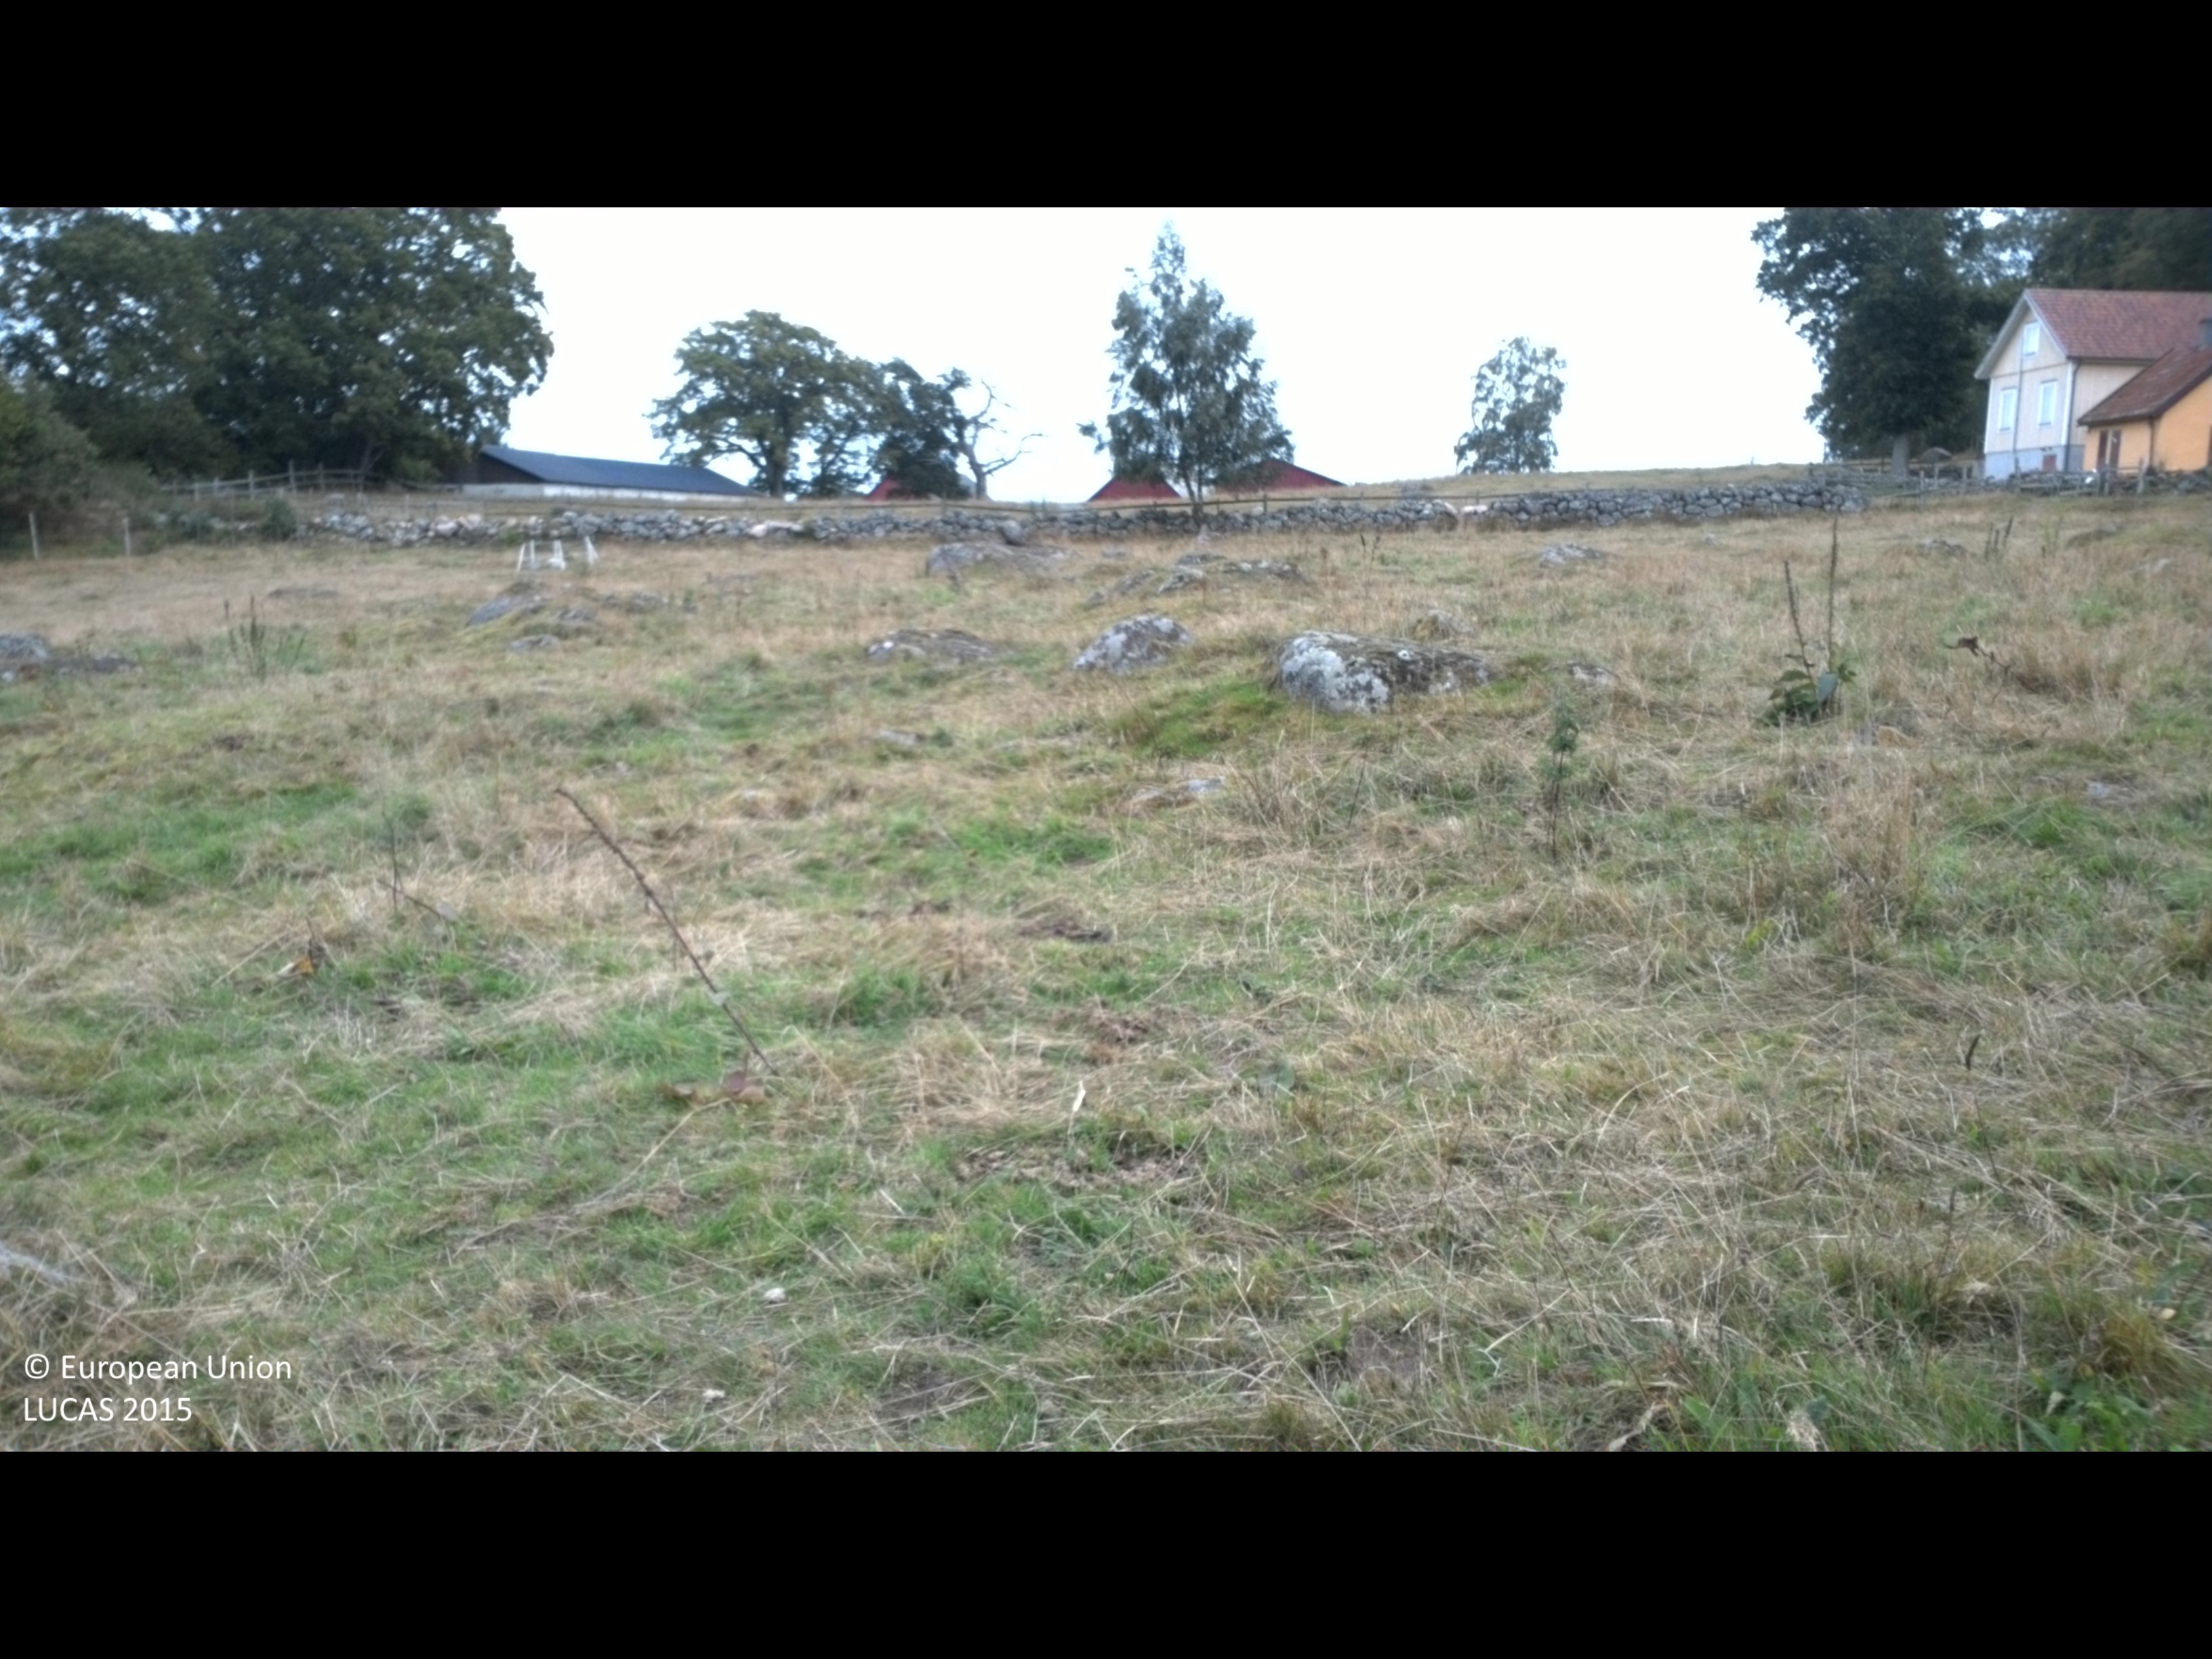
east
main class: Grassland
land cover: Grassland without tree/shrub cover
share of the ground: > 75 %
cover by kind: herbaceous plants 100 %
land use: Agriculture (excluding fallow land and kitchen gardens)
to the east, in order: Grassland without tree/shrub cover; Dry stone walls; Fences; Grassland without tree/shrub cover; Fences; Dry stone walls; Artificial constructions in urban areas
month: September
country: SE
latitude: 56.1244
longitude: 14.0354
